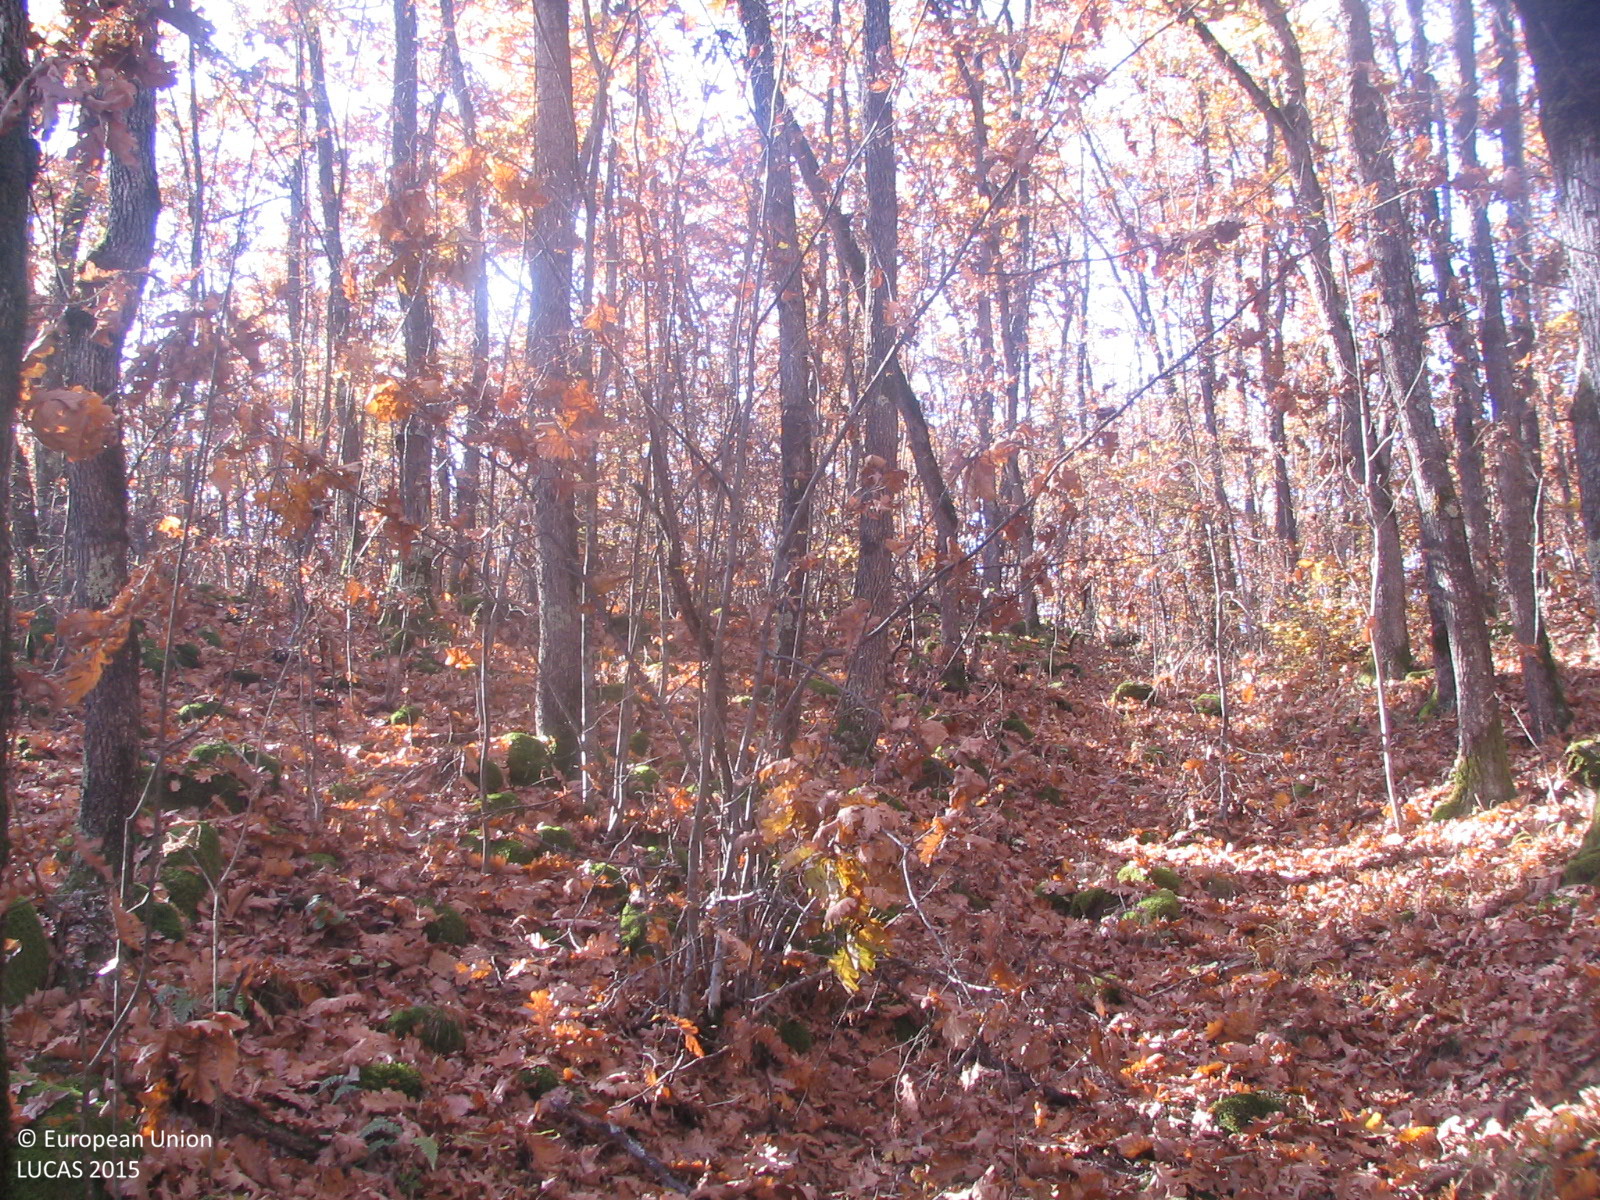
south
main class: Woodland
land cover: Broadleaved woodland
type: acidophilous oak and oak-birch forest
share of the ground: > 75 %
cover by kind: broadleaved forest trees 90 %, shrubs 5 %, herbaceous plants 5 %
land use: Forestry
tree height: > 5 m
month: November
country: BG
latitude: 43.0001
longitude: 23.8205
